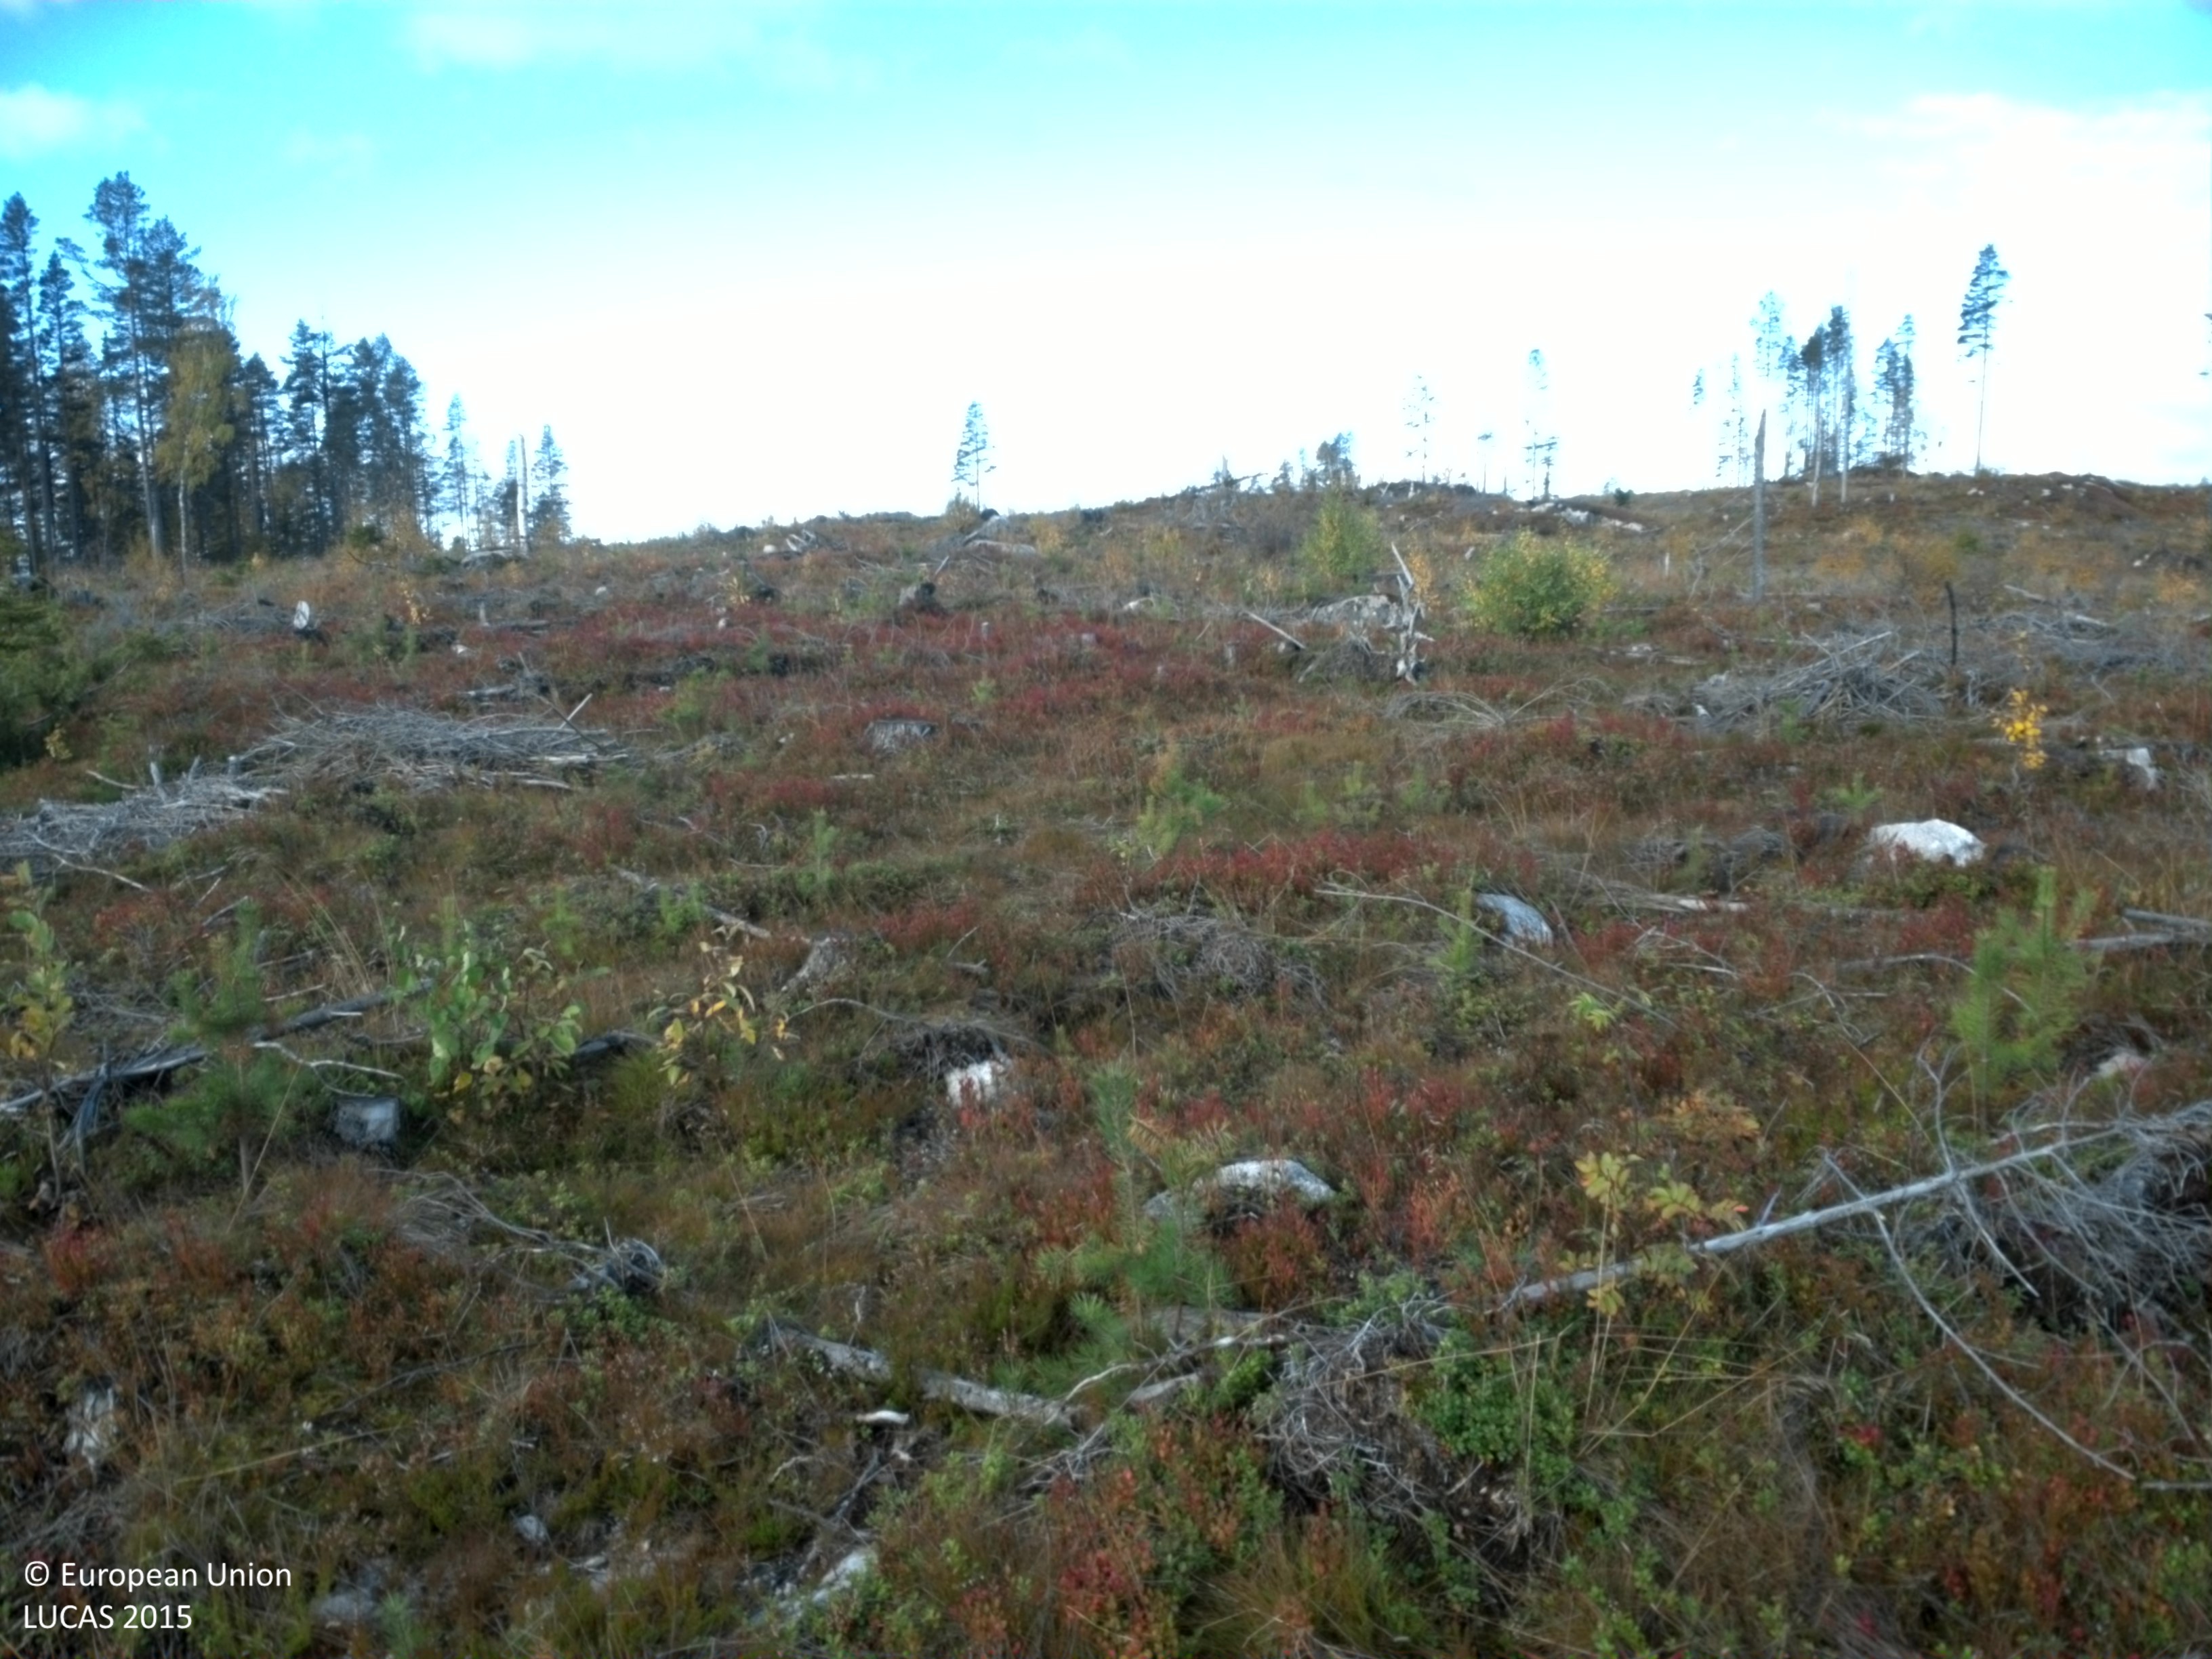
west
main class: Shrubland
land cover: Shrubland without tree cover
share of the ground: 50 - 75 %
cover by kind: shrubs 60 %, herbaceous plants 20 %, unconsolidated bare surface 10 %, lichens and mosses 5 %
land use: Forestry
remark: Clear cut
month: September
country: SE
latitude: 65.0198
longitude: 17.8794
